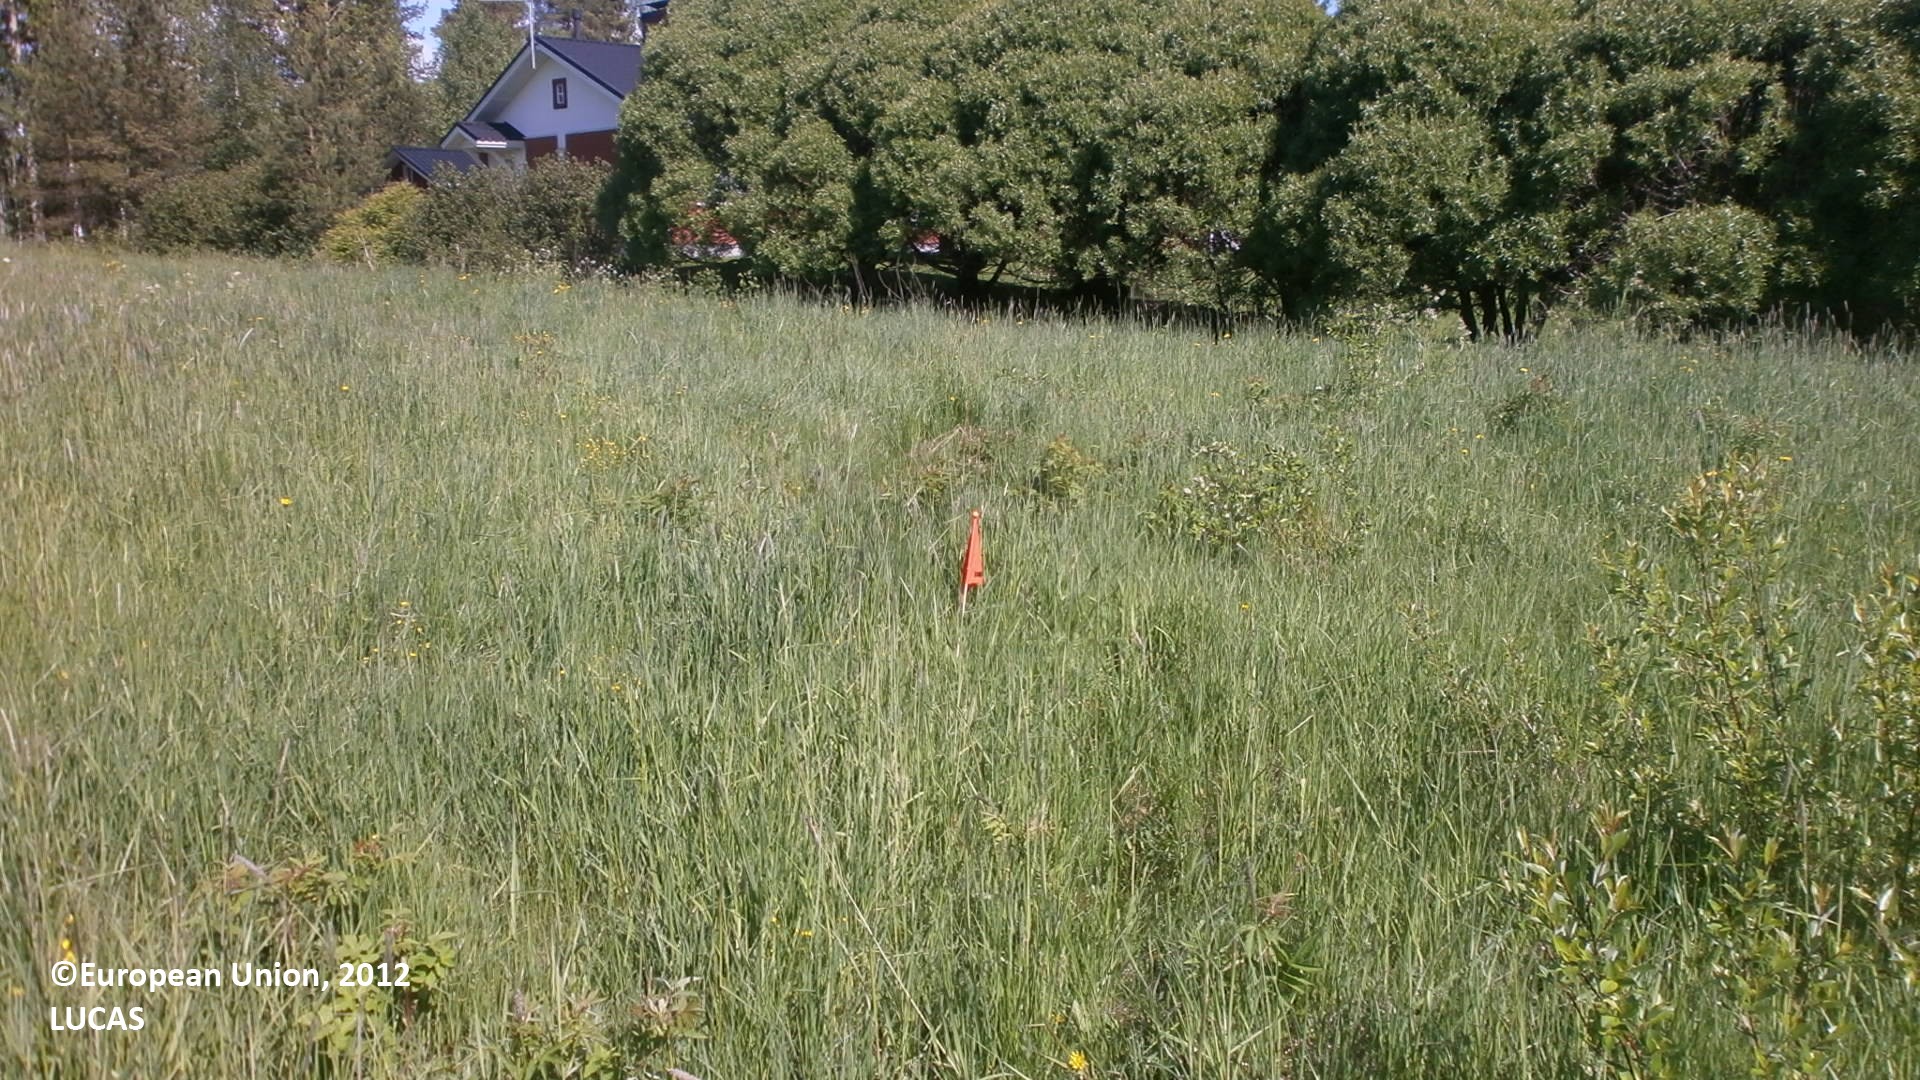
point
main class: Grassland
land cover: Grassland without tree/shrub cover
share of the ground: > 75 %
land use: Agriculture (excluding fallow land and kitchen gardens)
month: June
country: FI
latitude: 63.9803
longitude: 25.6897
